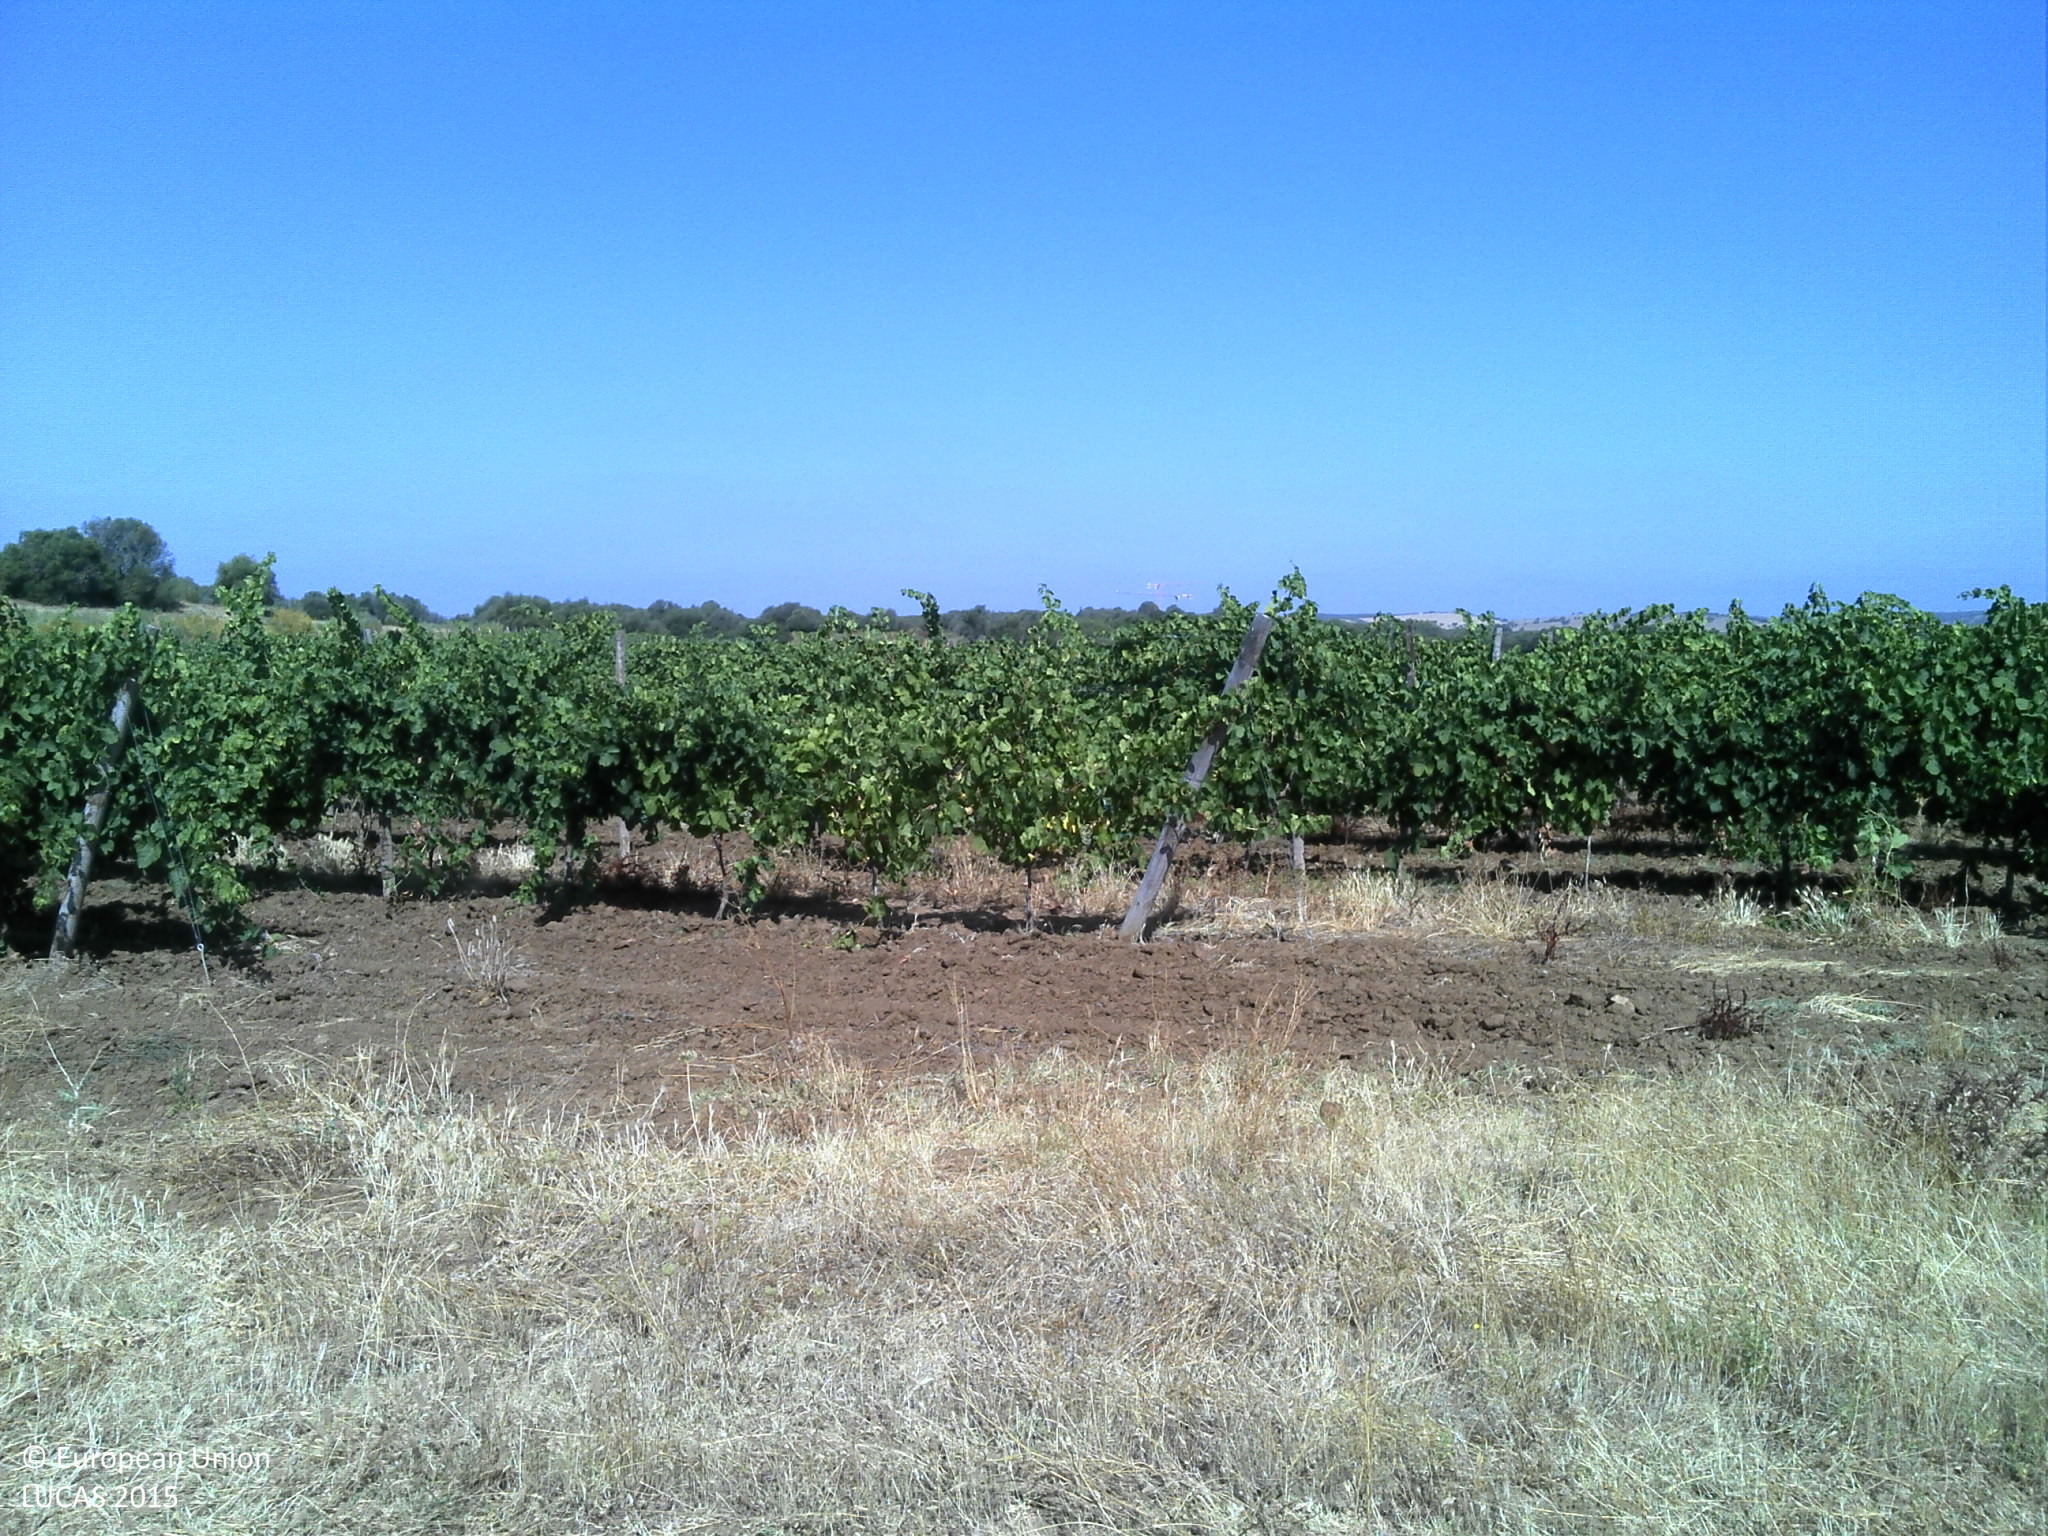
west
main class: Grassland
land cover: Grassland without tree/shrub cover
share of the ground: 50 - 75 %
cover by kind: herbaceous plants 50 %, unconsolidated bare surface 50 %
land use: Agriculture (excluding fallow land and kitchen gardens)
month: July
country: PT
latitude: 38.4395
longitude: -7.4052
